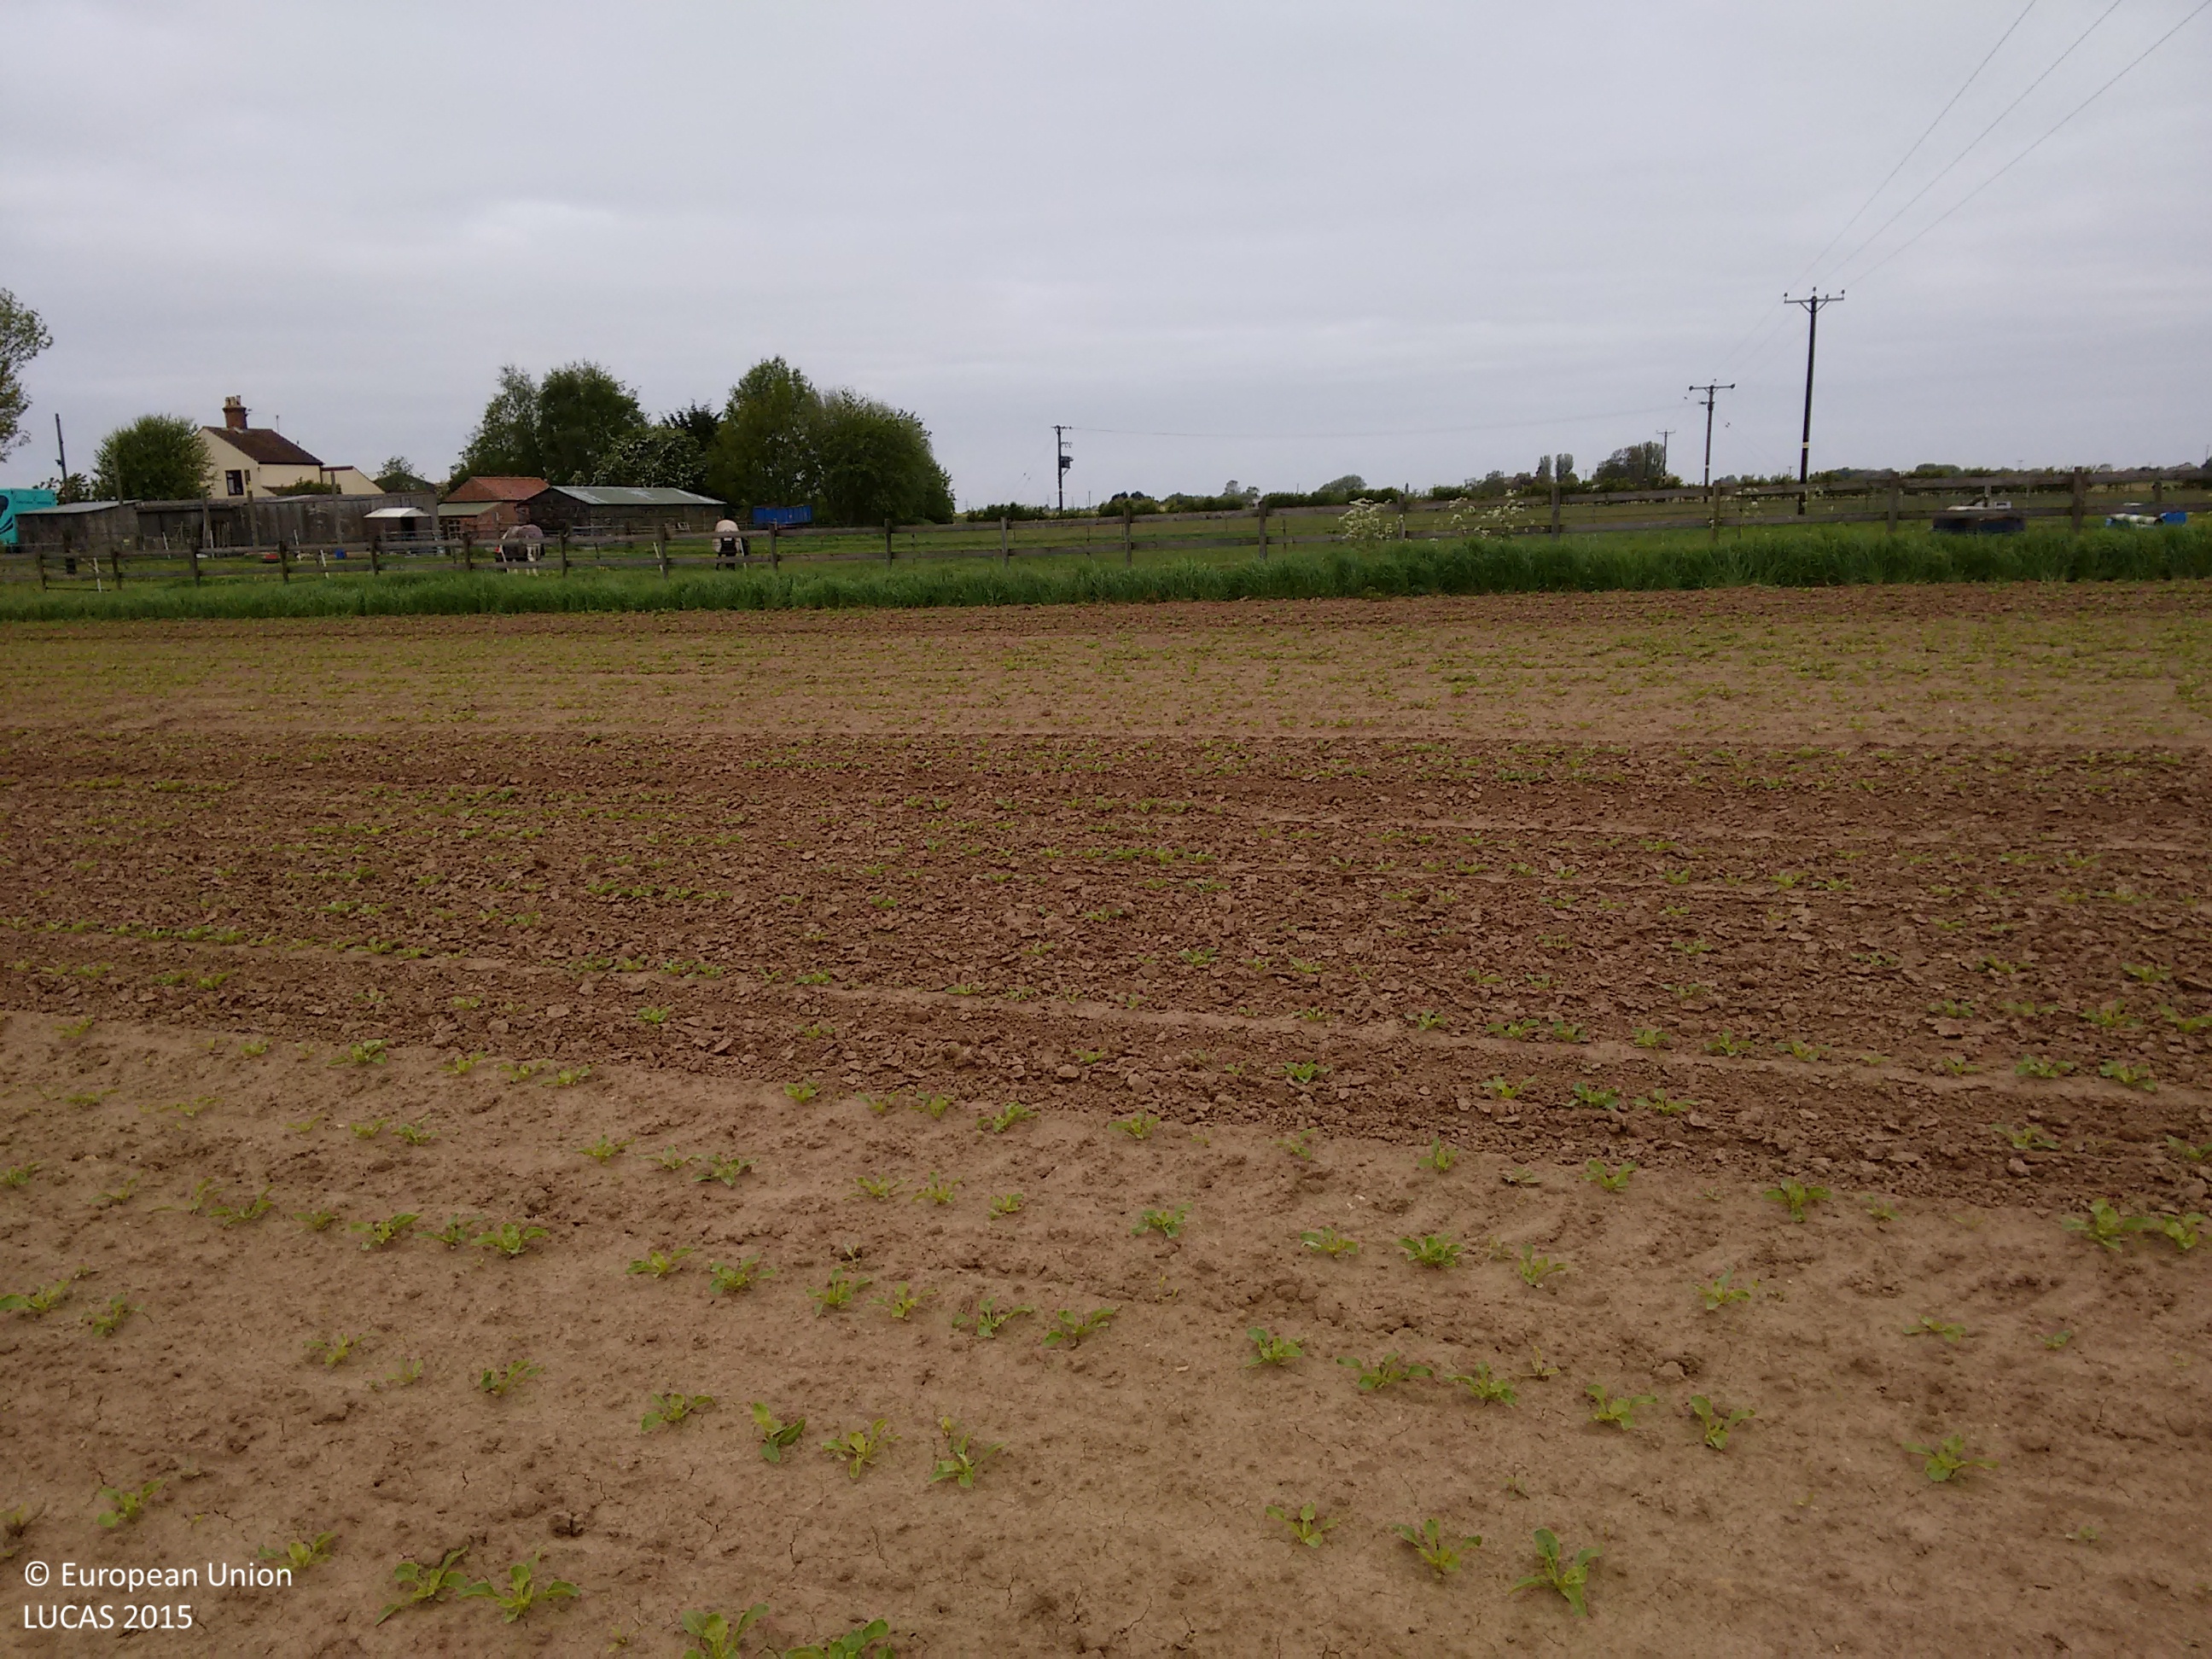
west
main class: Cropland
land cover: Other fresh vegetables
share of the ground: < 10 %
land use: Agriculture (excluding fallow land and kitchen gardens)
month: May
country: GB
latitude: 52.8731
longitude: -0.0614
